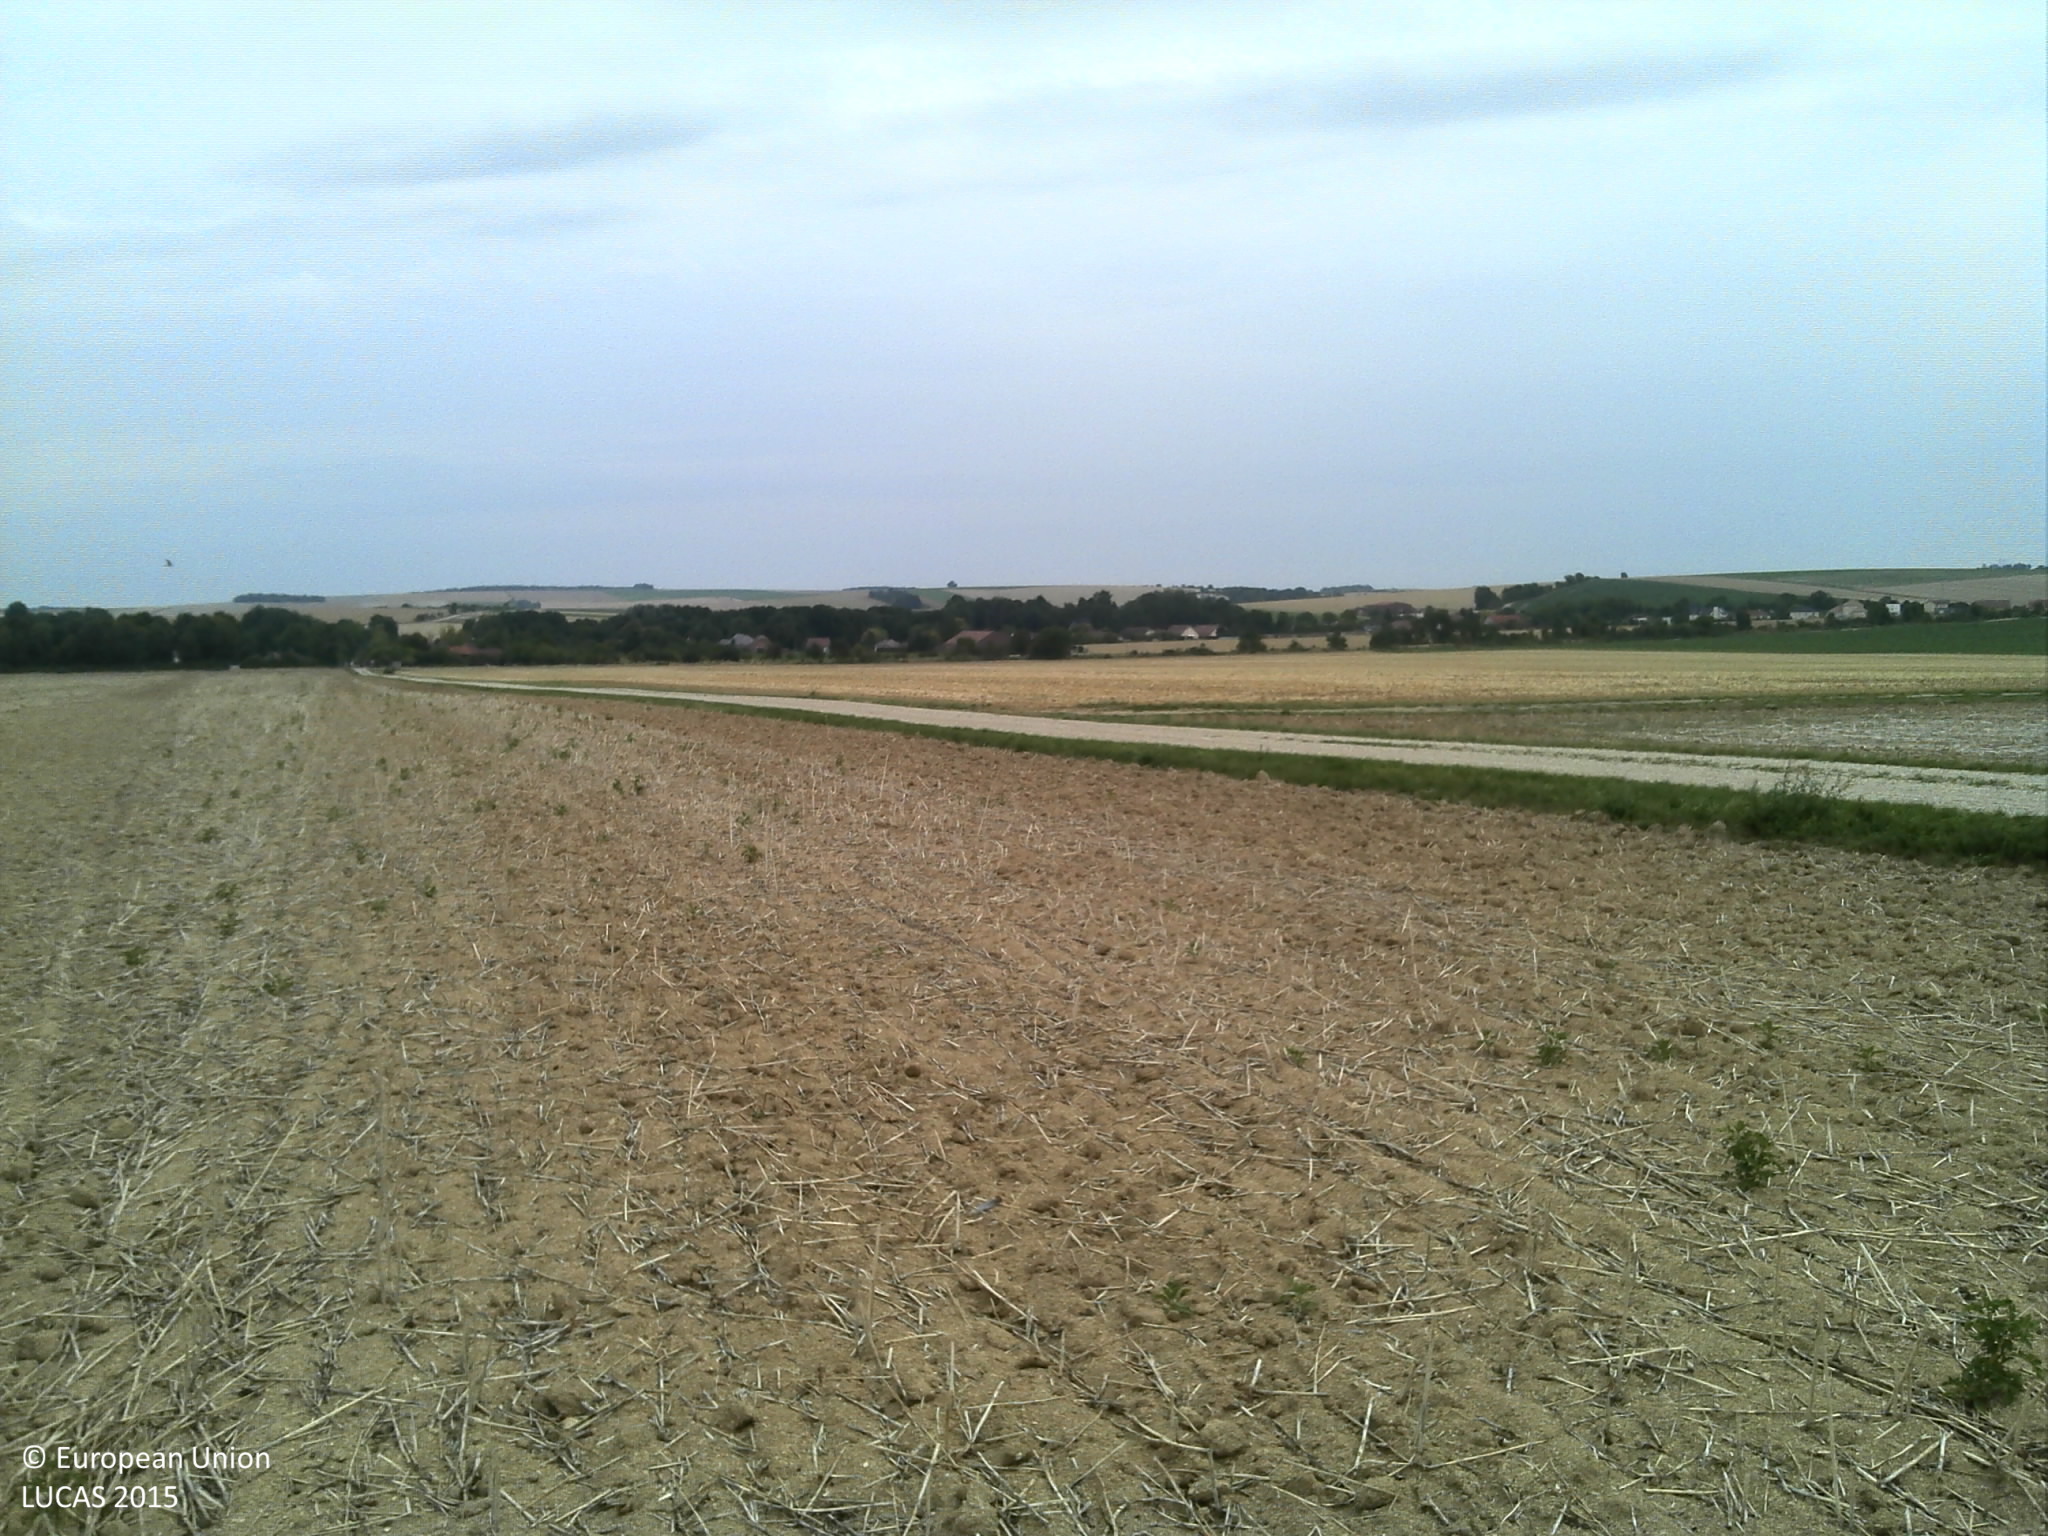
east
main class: Cropland
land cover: Other fibre and oleaginous crops
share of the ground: 10 - 25 %
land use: Agriculture (excluding fallow land and kitchen gardens)
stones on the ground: < 10 %
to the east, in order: Other fibre and oleaginous crops; Grass margins; Tracks; Grass margins; Rape and turnip rape; Grass margins; Tracks; Grass margins; Barley
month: August
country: FR
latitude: 48.3943
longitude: 4.1755
